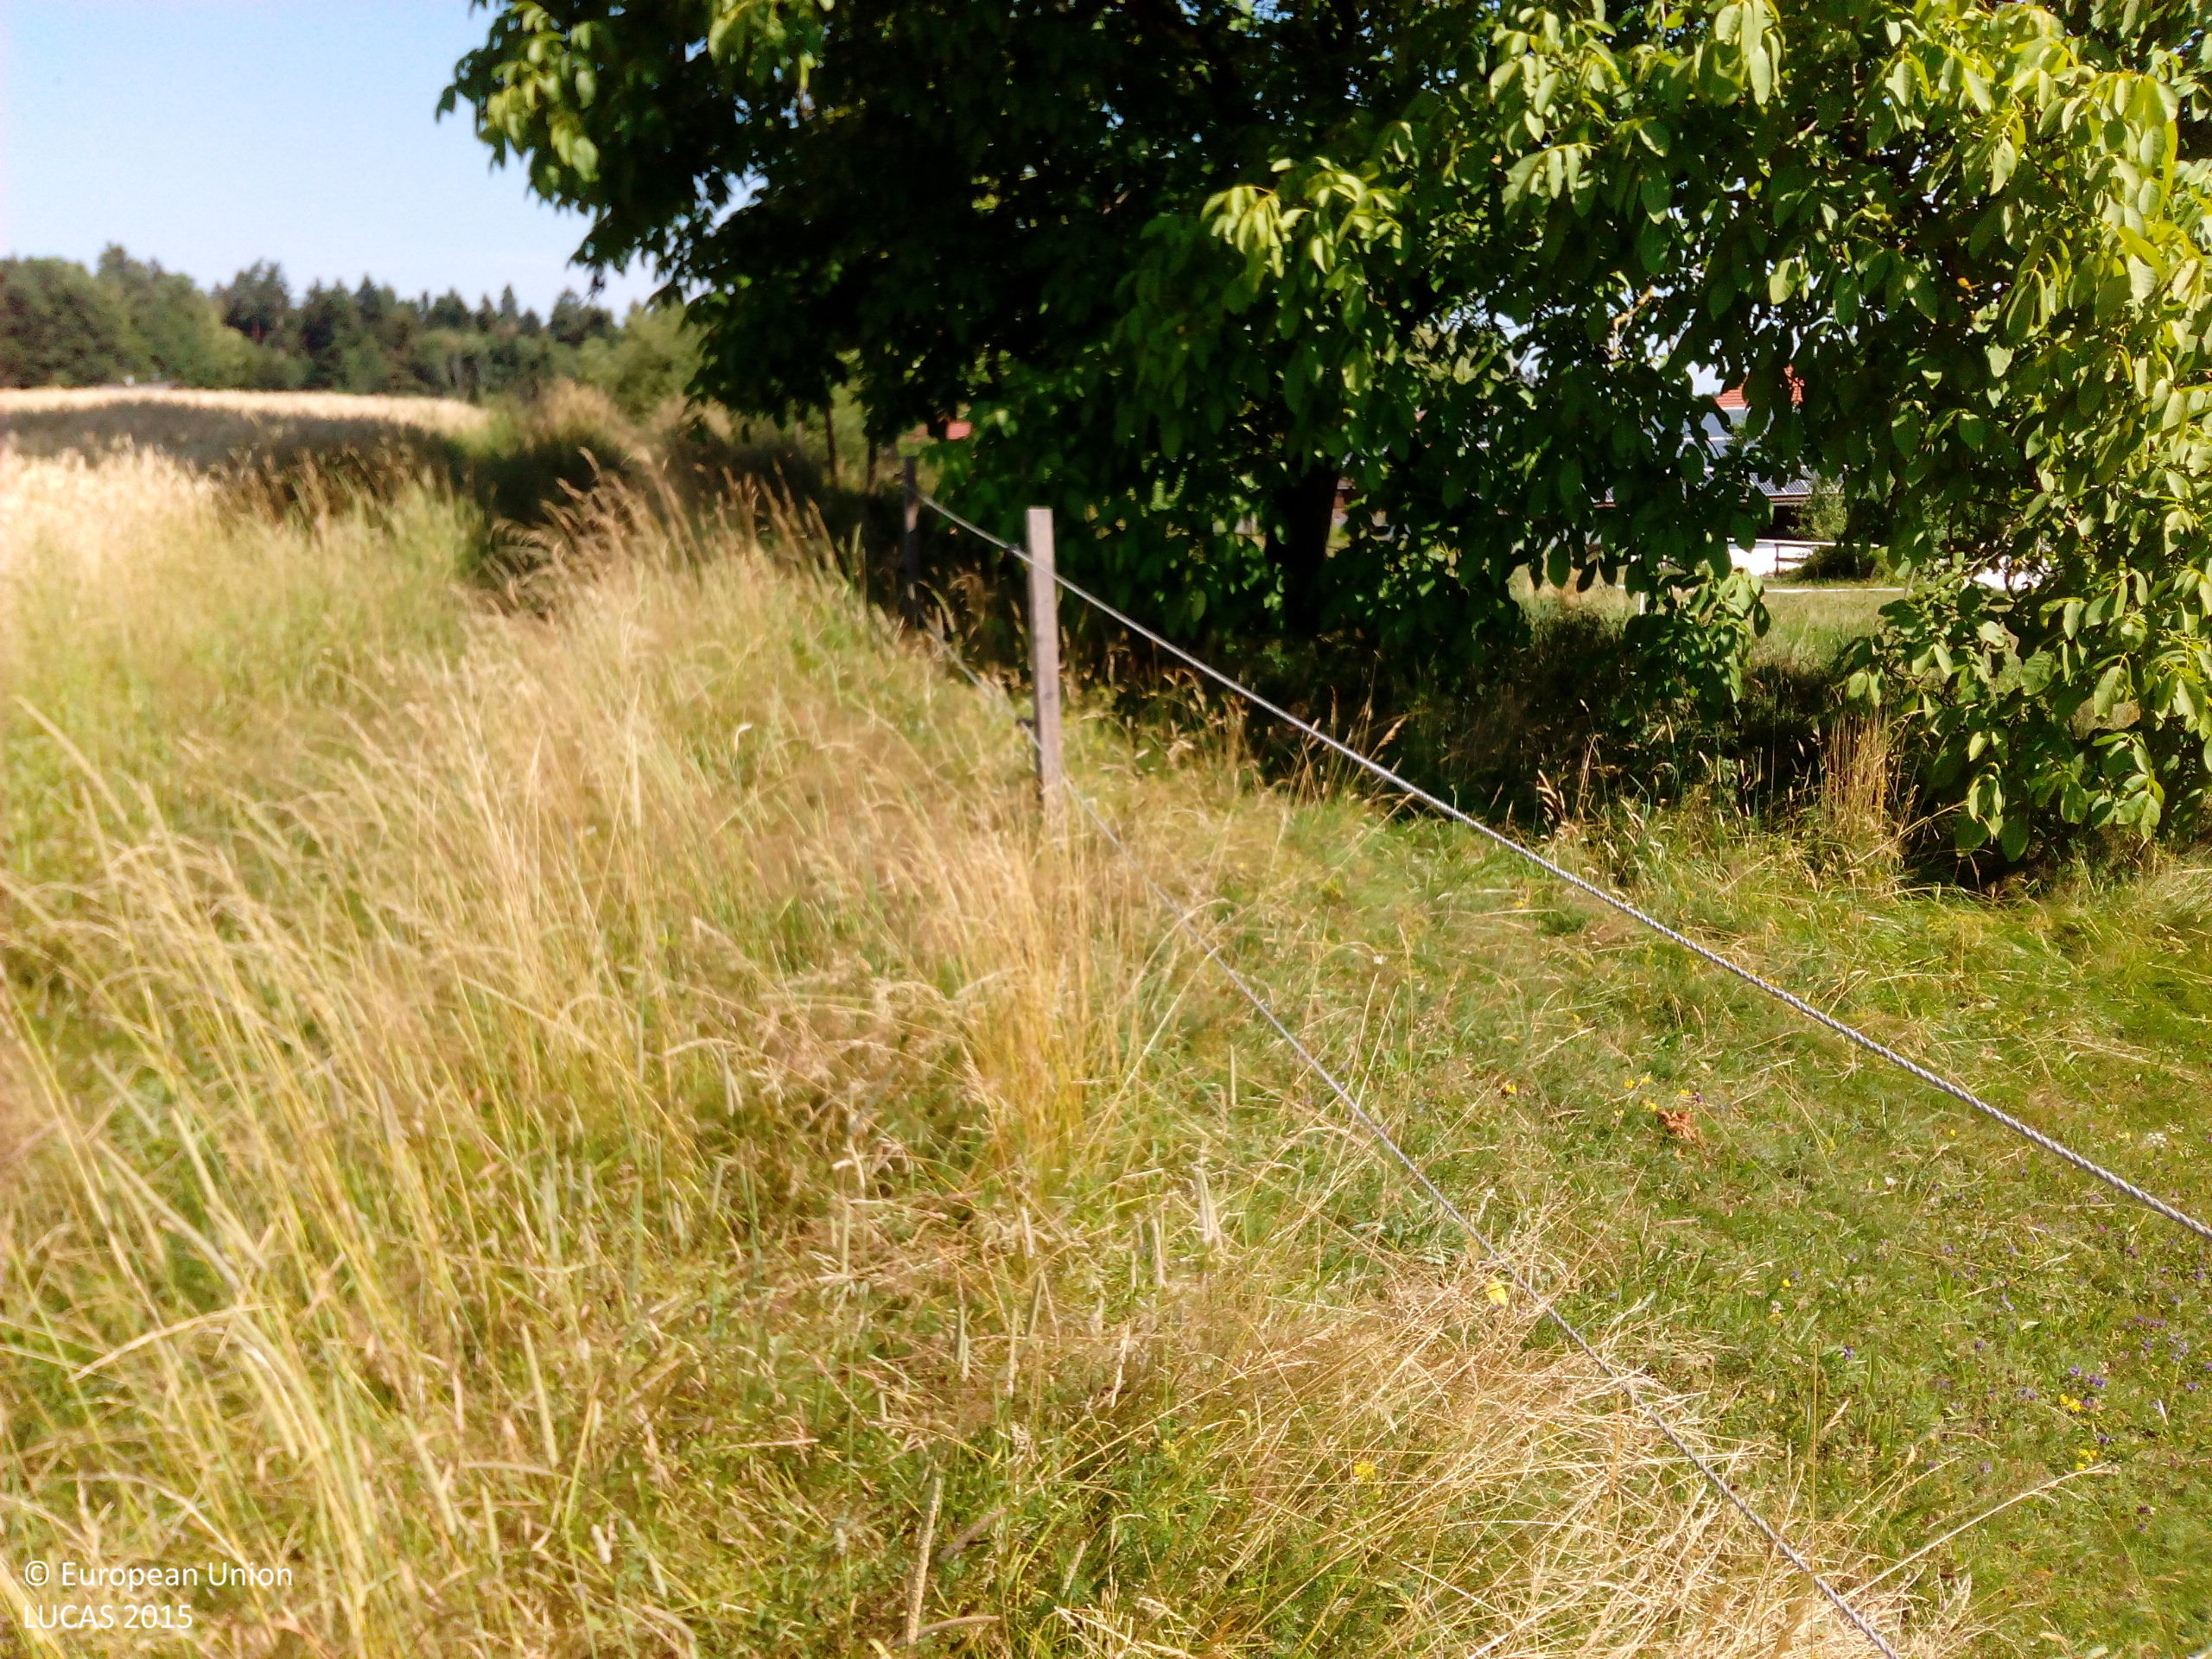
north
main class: Cropland
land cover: Apple fruit
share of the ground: 10 - 25 %
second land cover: Grassland without tree/shrub cover
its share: > 75 %
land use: Agriculture (excluding fallow land and kitchen gardens)
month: July
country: DE
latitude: 48.5805
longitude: 12.9408
